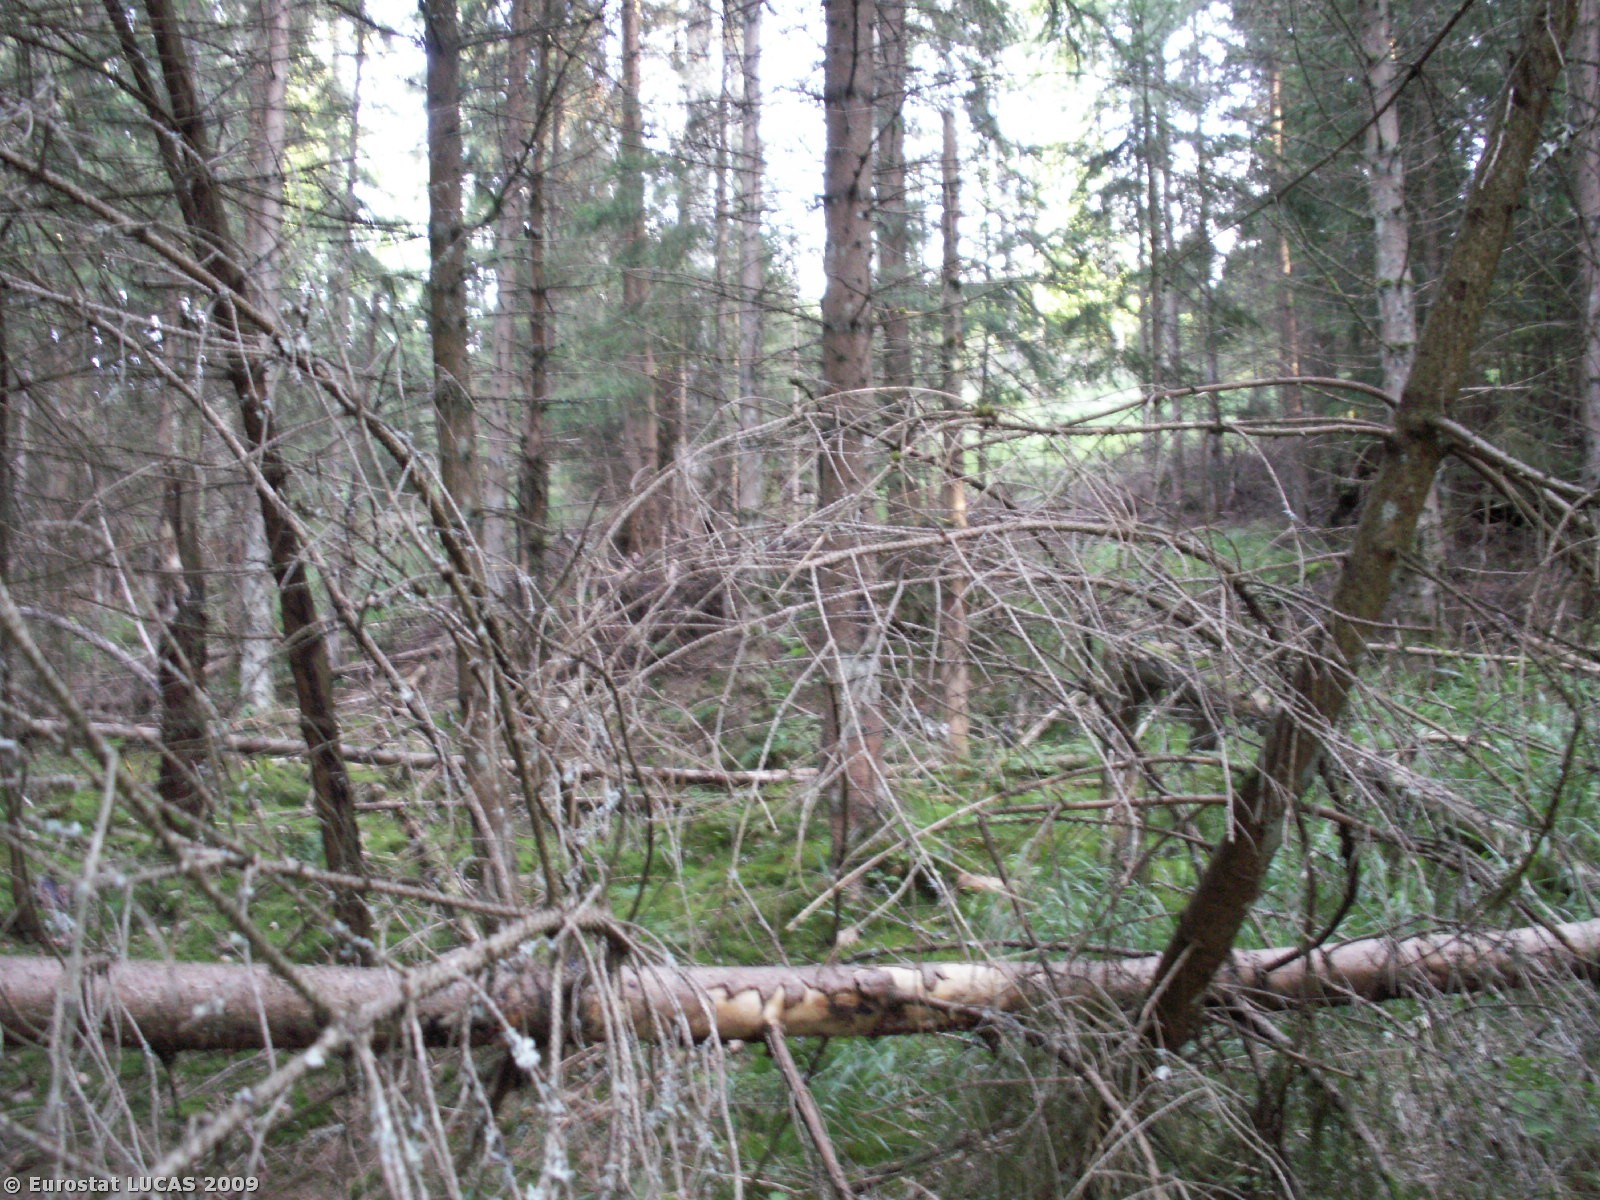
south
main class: Woodland
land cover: Coniferous woodland
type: hemiboreal forest and nemoral coniferous forest and mixed broadleaved-coniferous forest
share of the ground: > 75 %
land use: Forestry
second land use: Nature reserves
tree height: > 5 m
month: July
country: CZ
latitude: 48.8415
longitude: 13.8289
